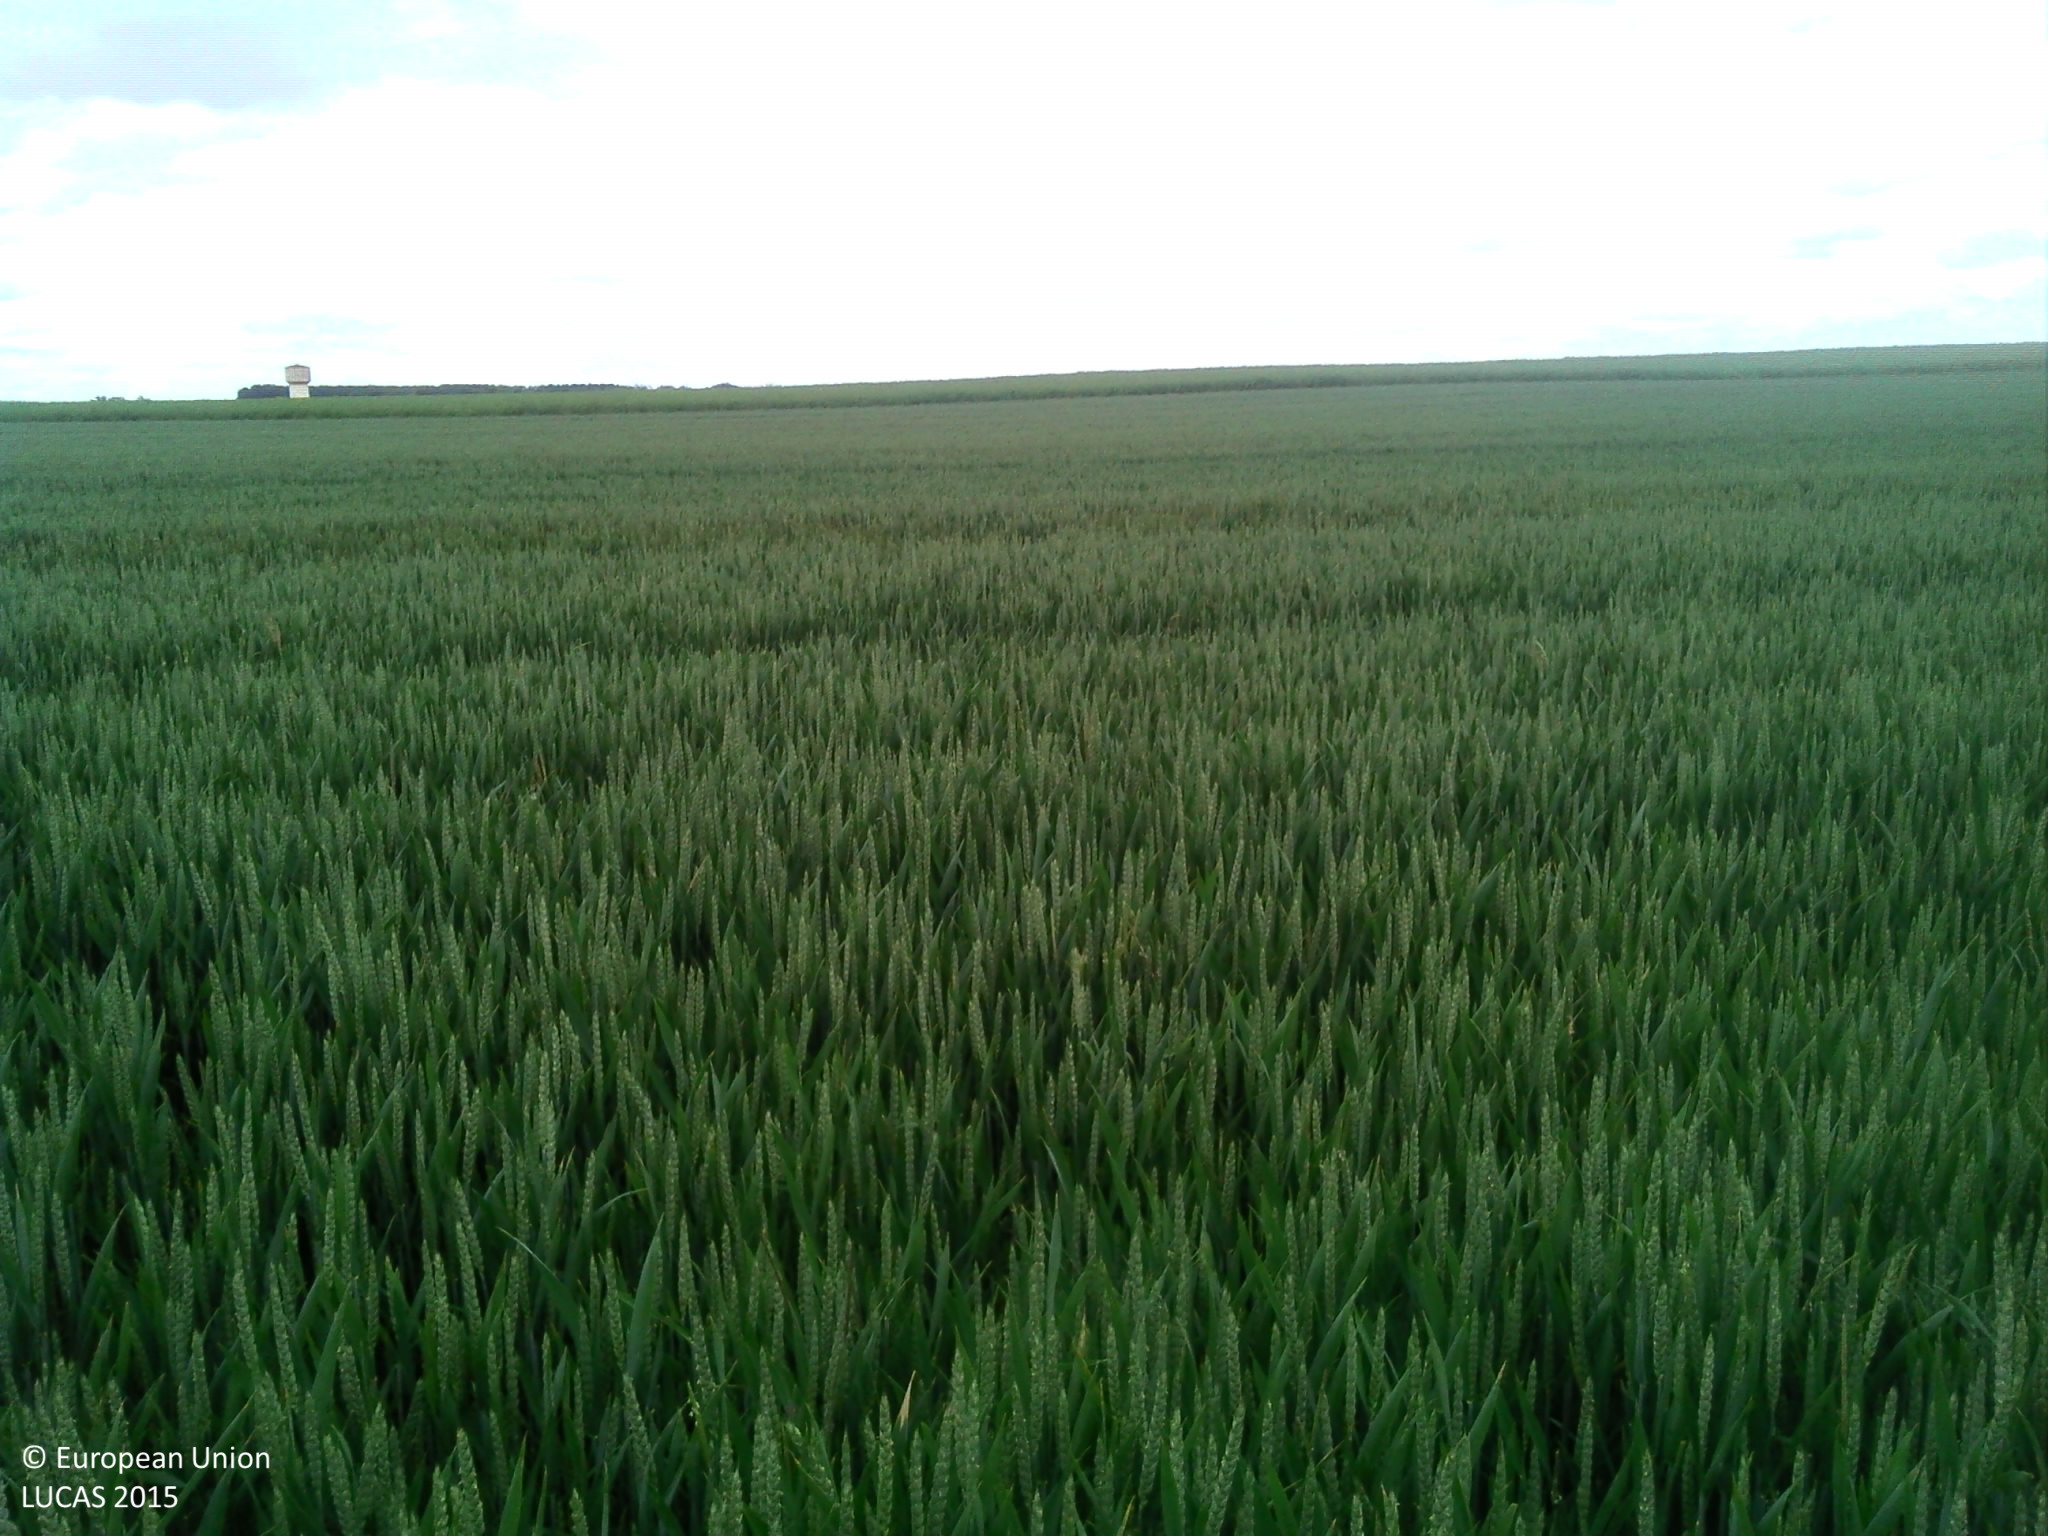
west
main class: Cropland
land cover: Rape and turnip rape
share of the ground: > 75 %
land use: Agriculture (excluding fallow land and kitchen gardens)
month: June
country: FR
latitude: 49.7306
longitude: 3.2351
